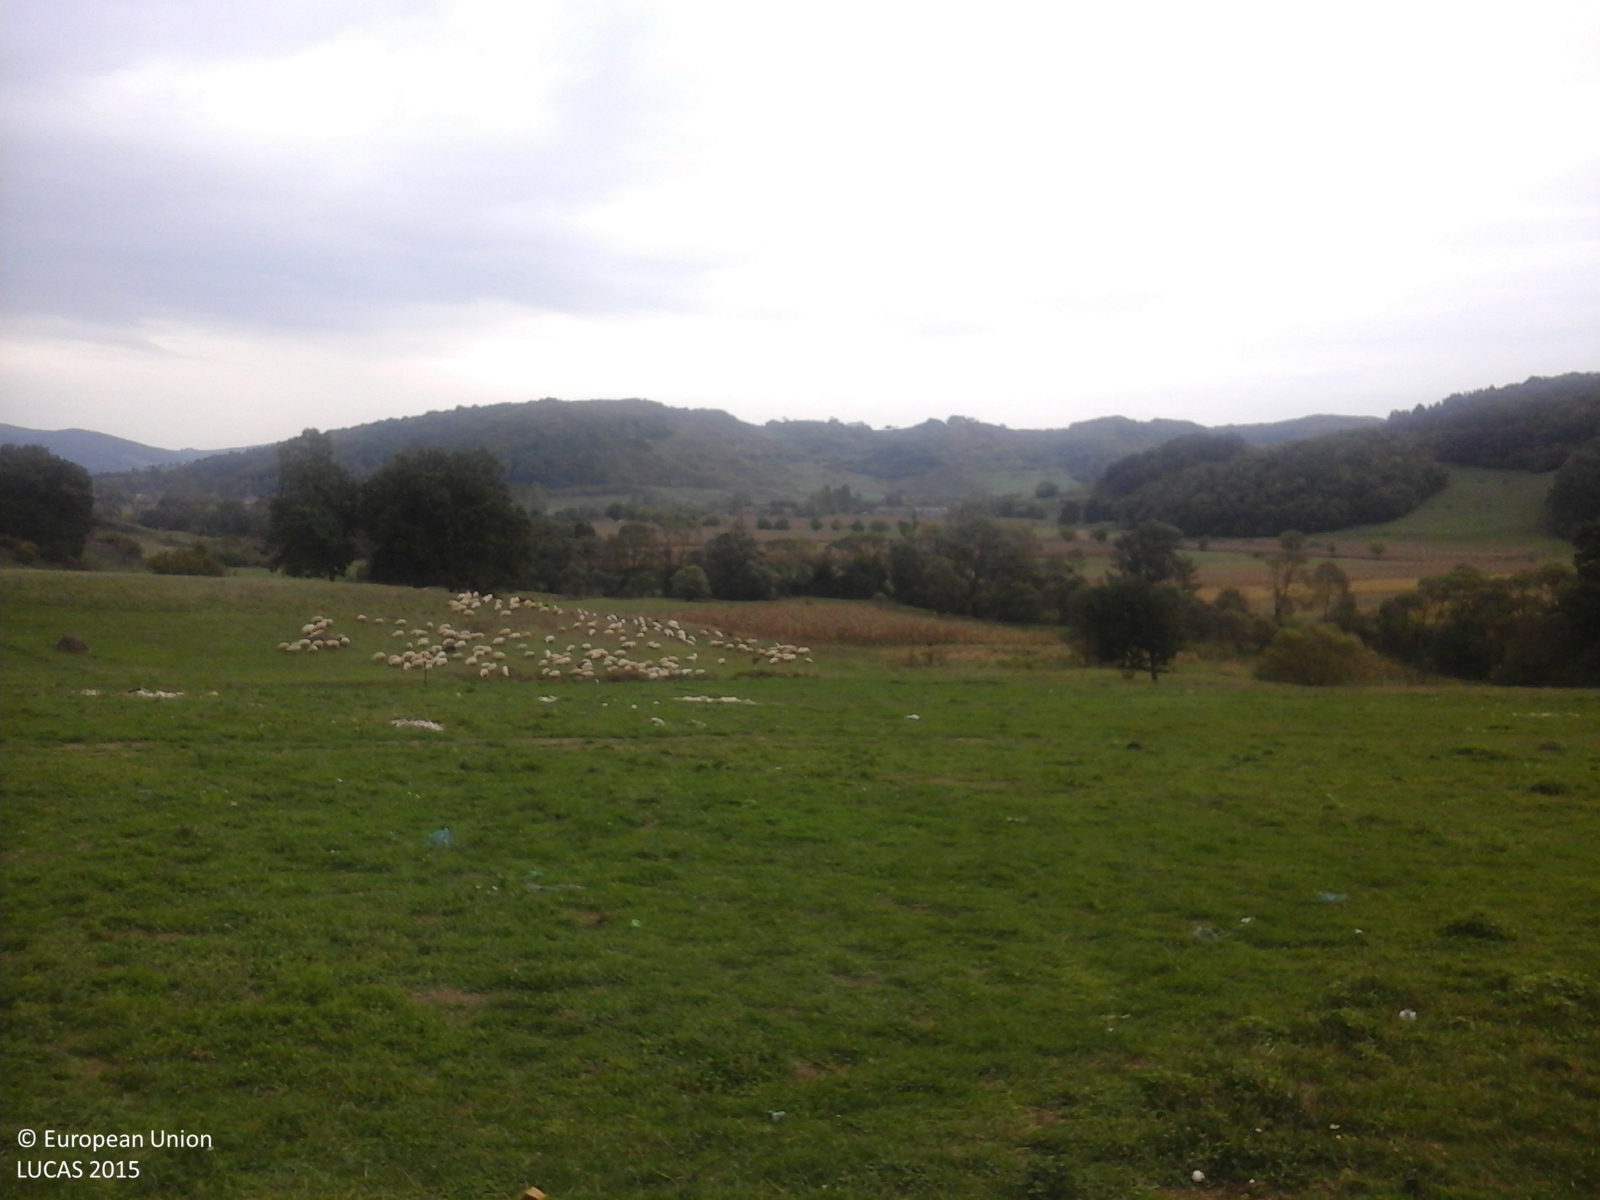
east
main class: Grassland
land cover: Grassland without tree/shrub cover
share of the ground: > 75 %
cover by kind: herbaceous plants 100 %
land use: Agriculture (excluding fallow land and kitchen gardens)
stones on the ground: < 10 %
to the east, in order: Grassland without tree/shrub cover; Tracks; Grassland without tree/shrub cover; Tracks; Grassland without tree/shrub cover; Ditches and canals; Grassland without tree/shrub cover; Single bushes/trees; Tracks; Spontaneously vegetated surfaces; Fences; Grassland without tree/shrub cover
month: October
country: RO
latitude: 46.5525
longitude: 24.8458
